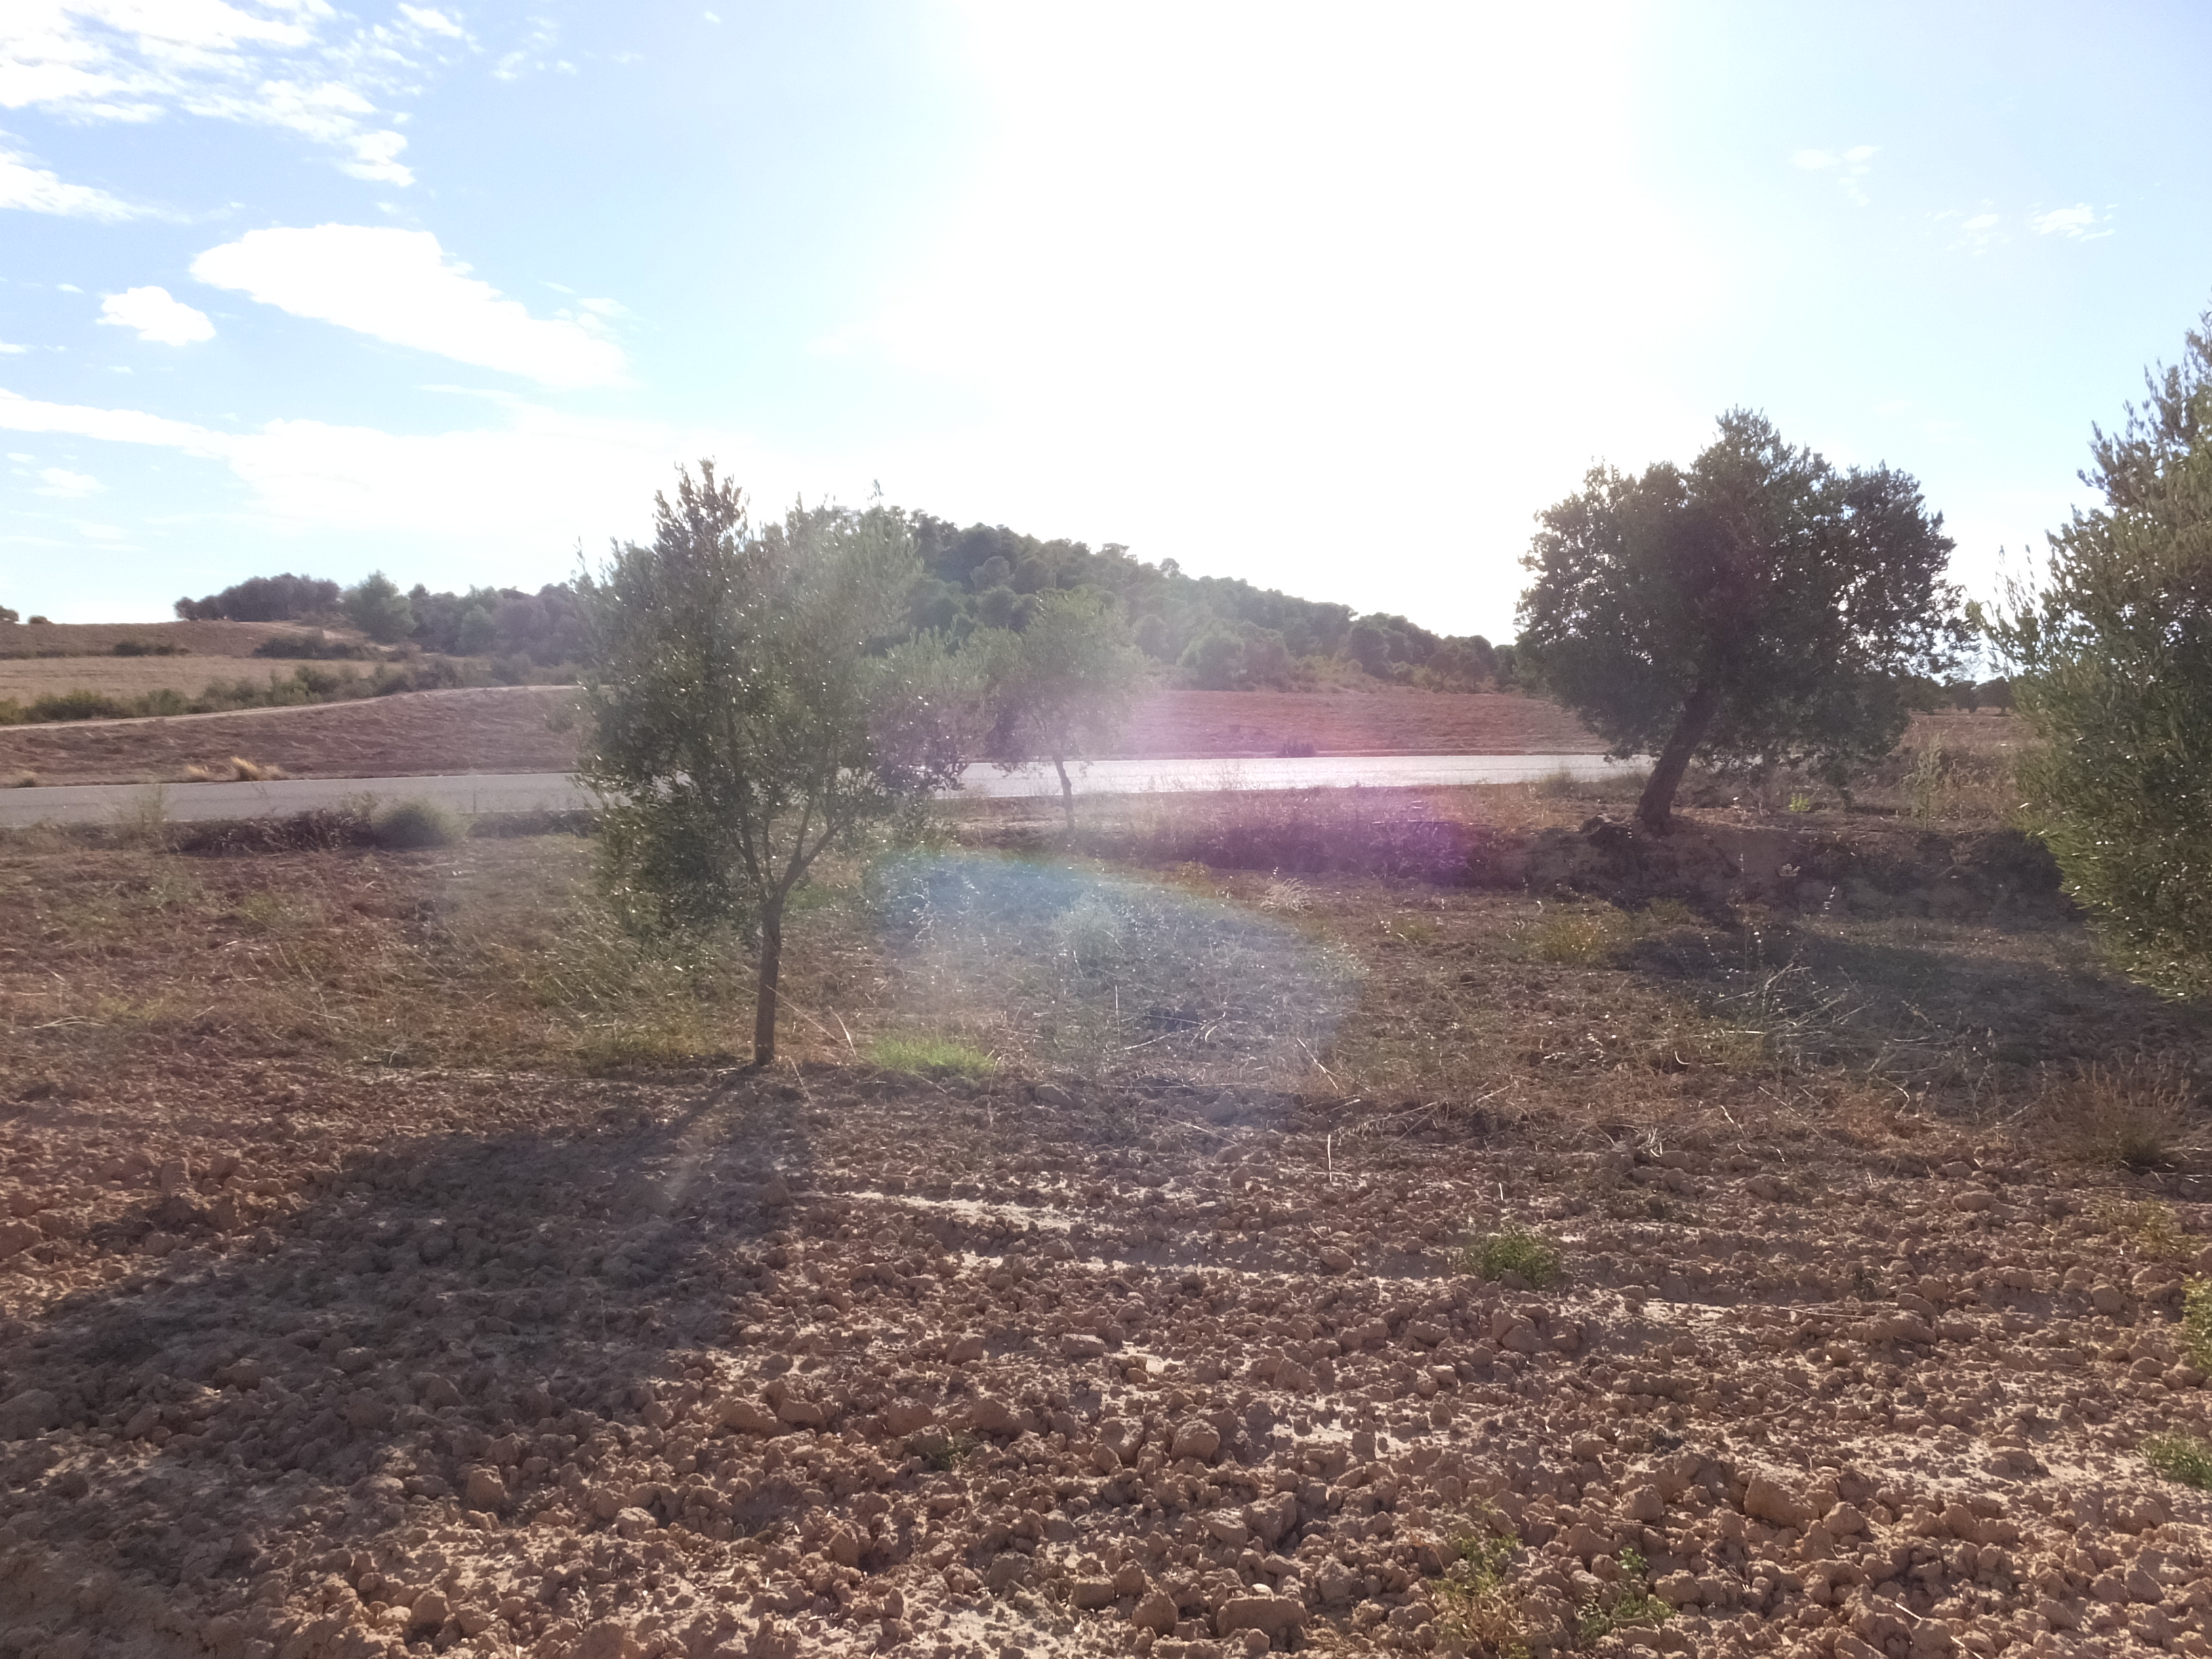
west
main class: Cropland
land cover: Olive groves
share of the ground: > 75 %
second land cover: Spontaneously vegetated surfaces
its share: < 10 %
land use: Agriculture (excluding fallow land and kitchen gardens)
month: August
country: ES
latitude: 41.2516
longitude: 0.2148
